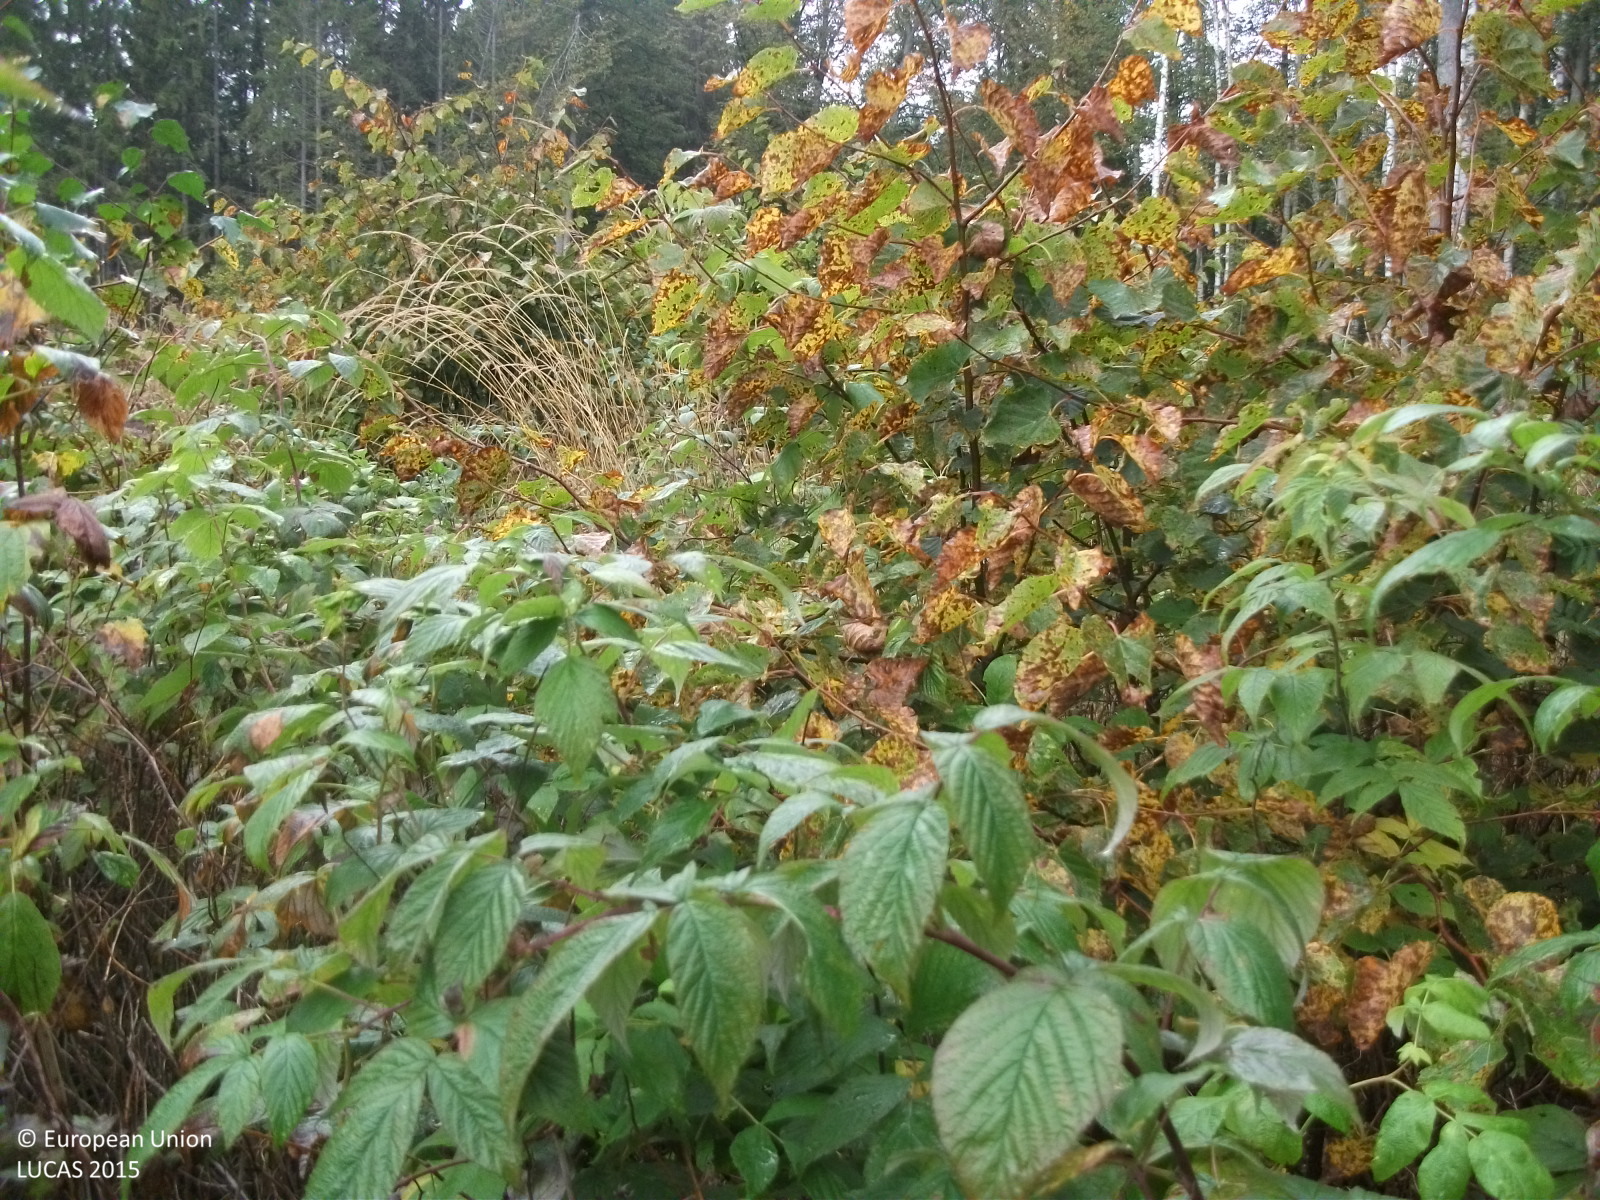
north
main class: Shrubland
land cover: Shrubland with sparse tree cover
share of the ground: > 75 %
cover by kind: shrubs 70 %, herbaceous plants 25 %, broadleaved forest trees 5 %
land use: Forestry
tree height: < 5 m
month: September
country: LV
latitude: 57.7403
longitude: 24.4850
